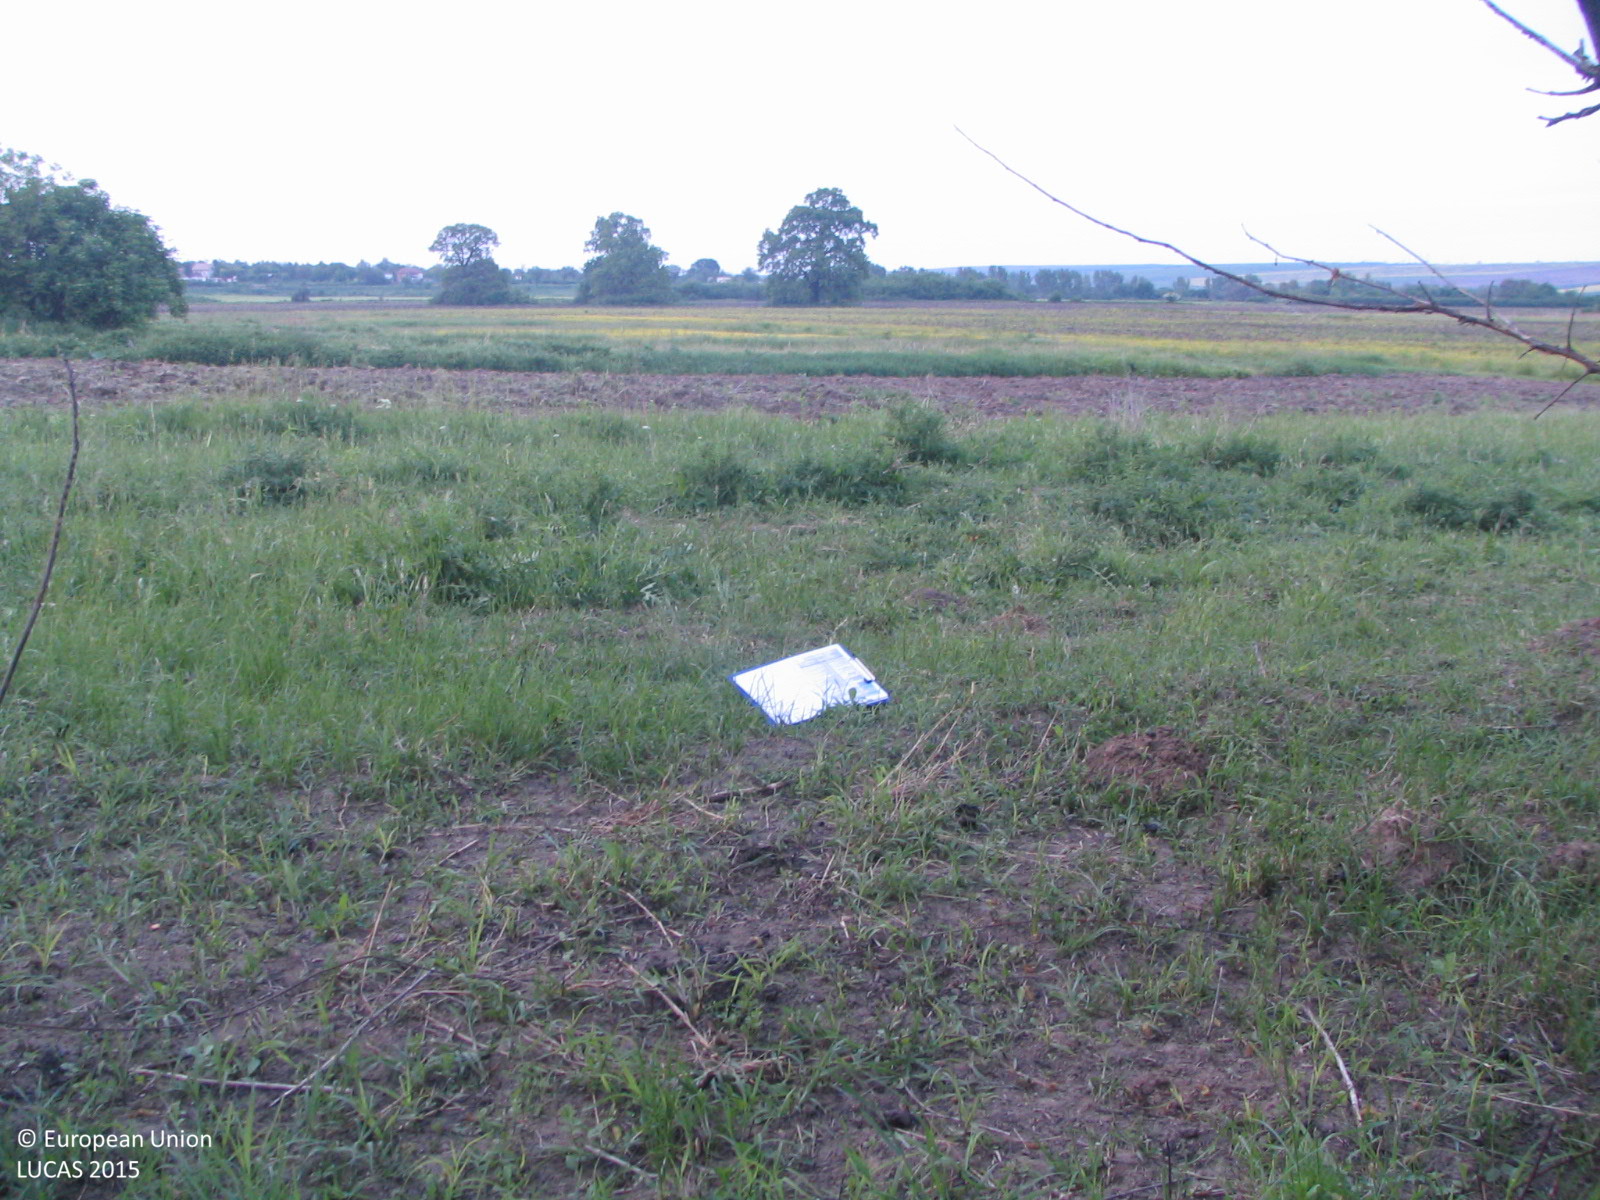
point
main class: Grassland
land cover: Grassland with sparse tree/shrub cover
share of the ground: > 75 %
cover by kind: herbaceous plants 90 %, broadleaved forest trees 5 %, shrubs 5 %
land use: Abandoned areas
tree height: > 5 m
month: May
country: BG
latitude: 43.6363
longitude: 23.8476
